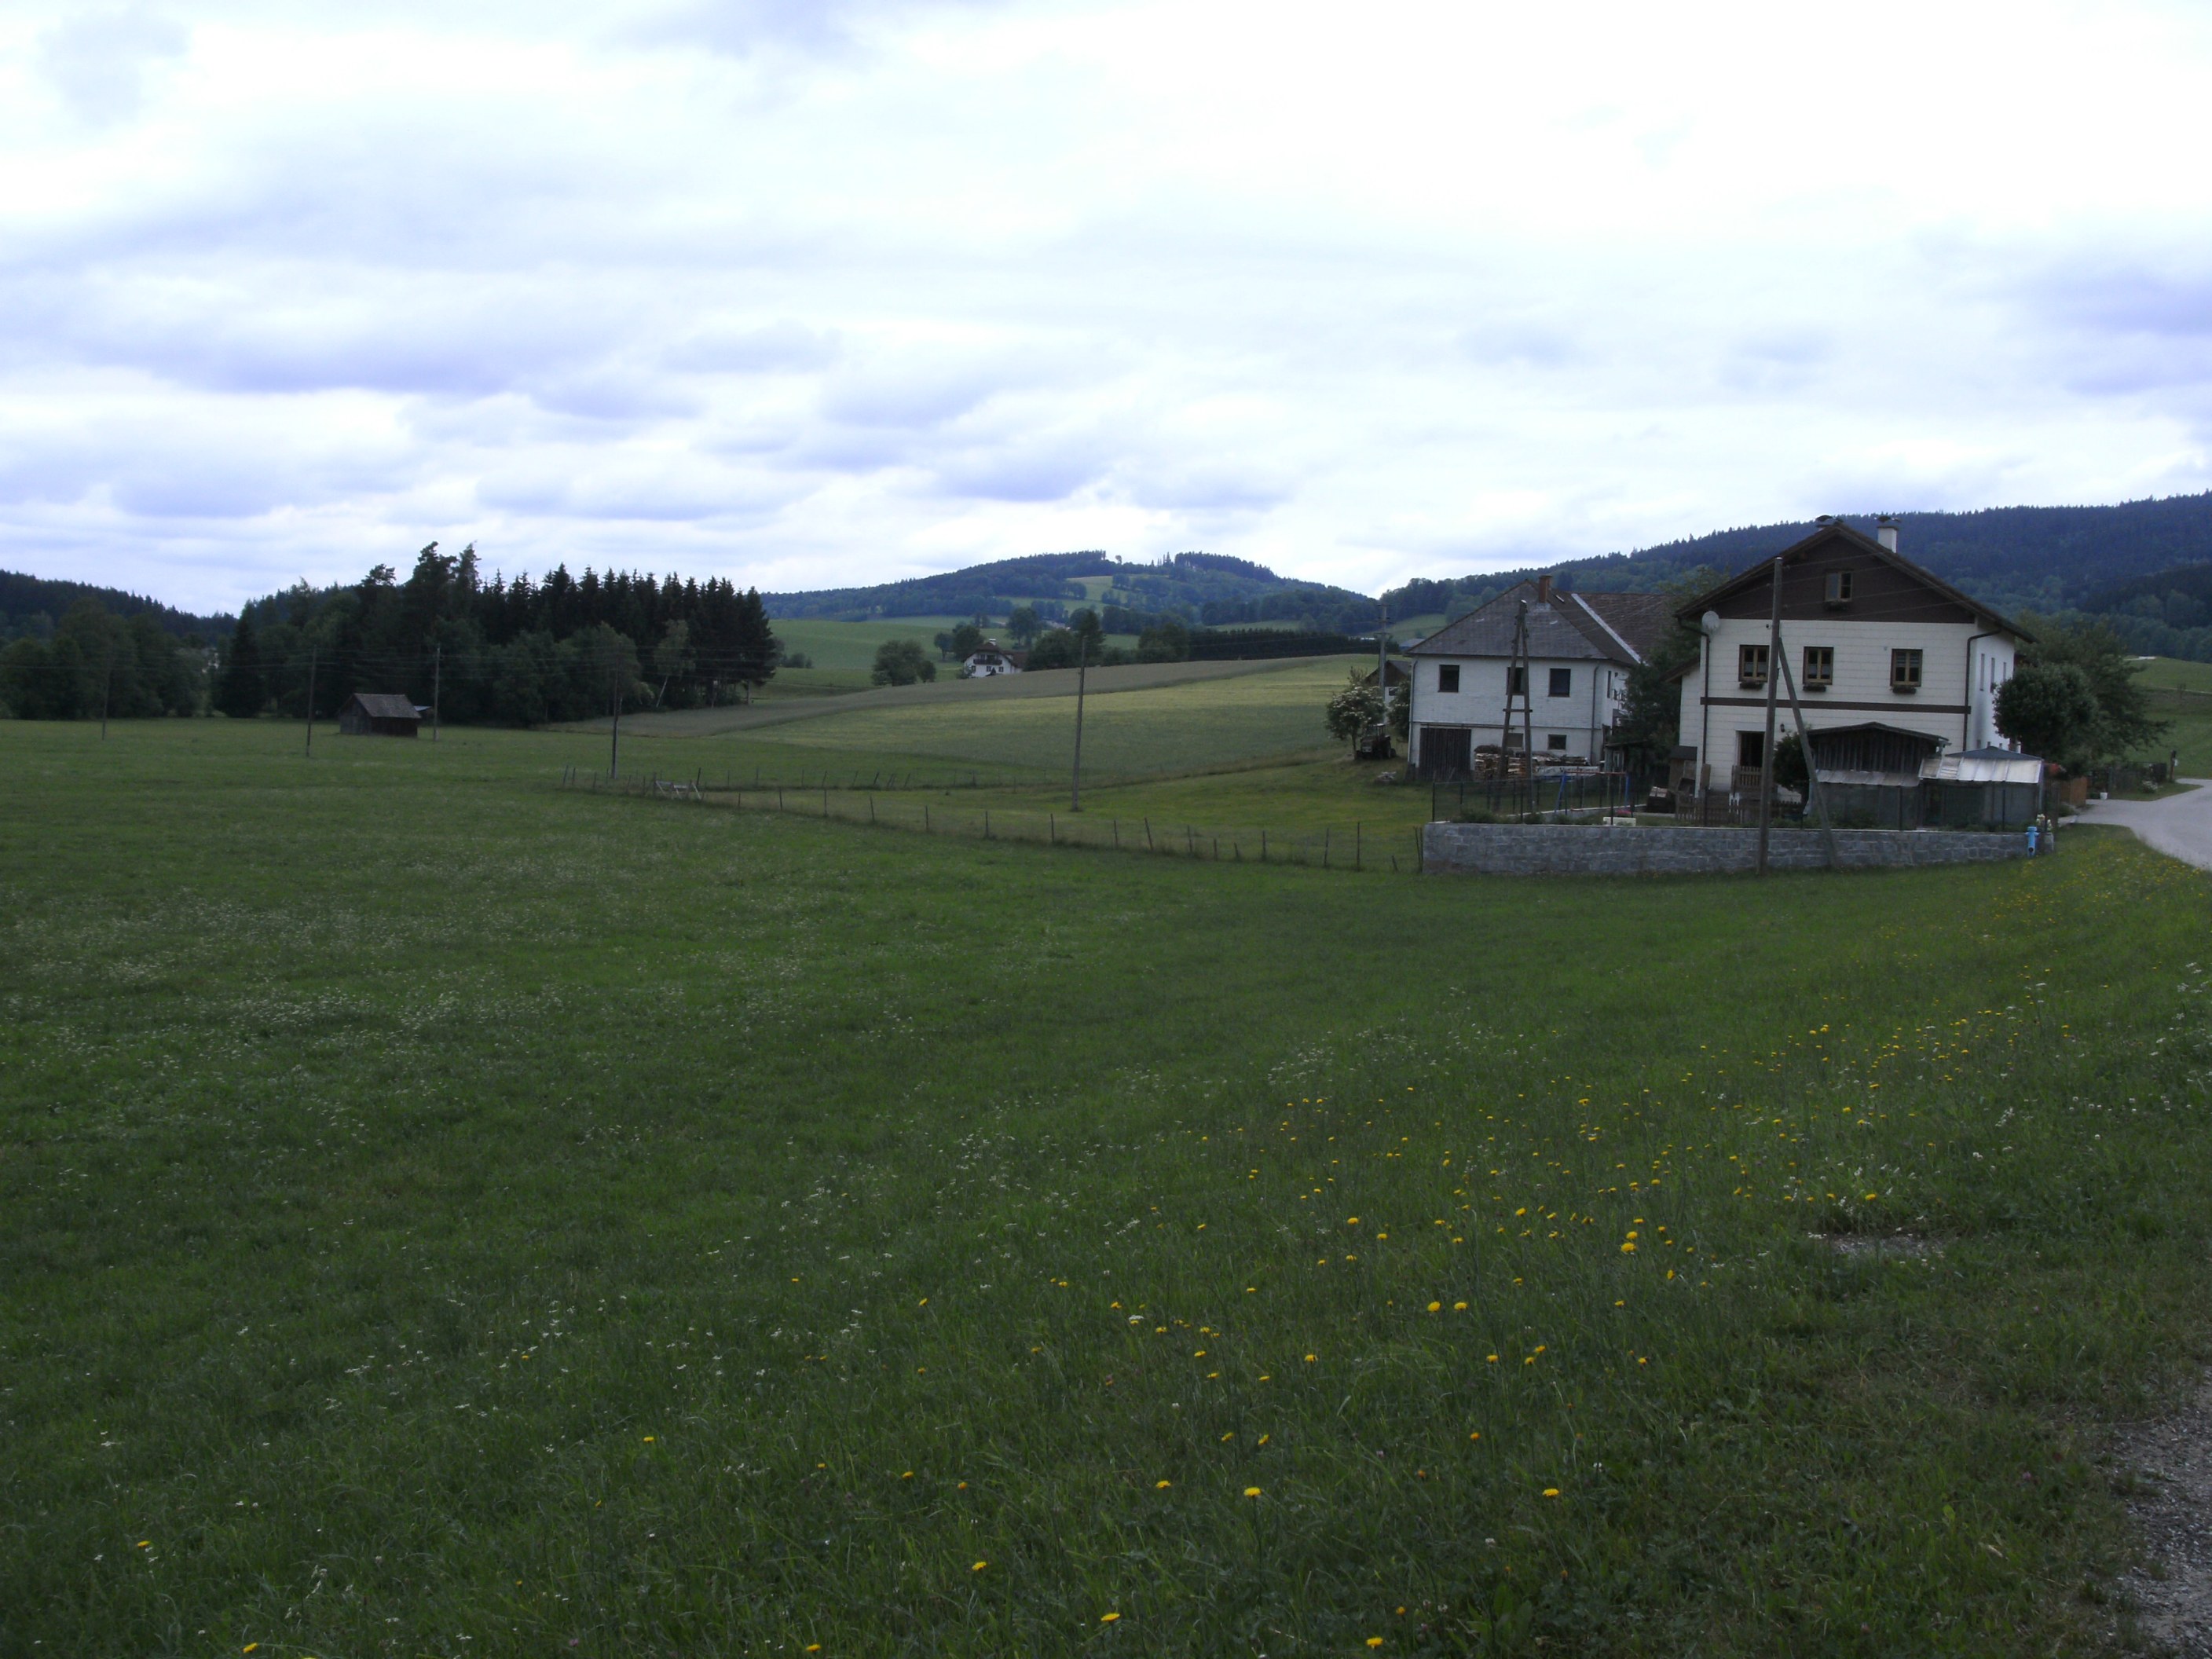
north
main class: Grassland
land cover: Grassland without tree/shrub cover
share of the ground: > 75 %
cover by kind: herbaceous plants 100 %
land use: Agriculture (excluding fallow land and kitchen gardens)
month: June
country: AT
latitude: 48.5585
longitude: 14.1870
